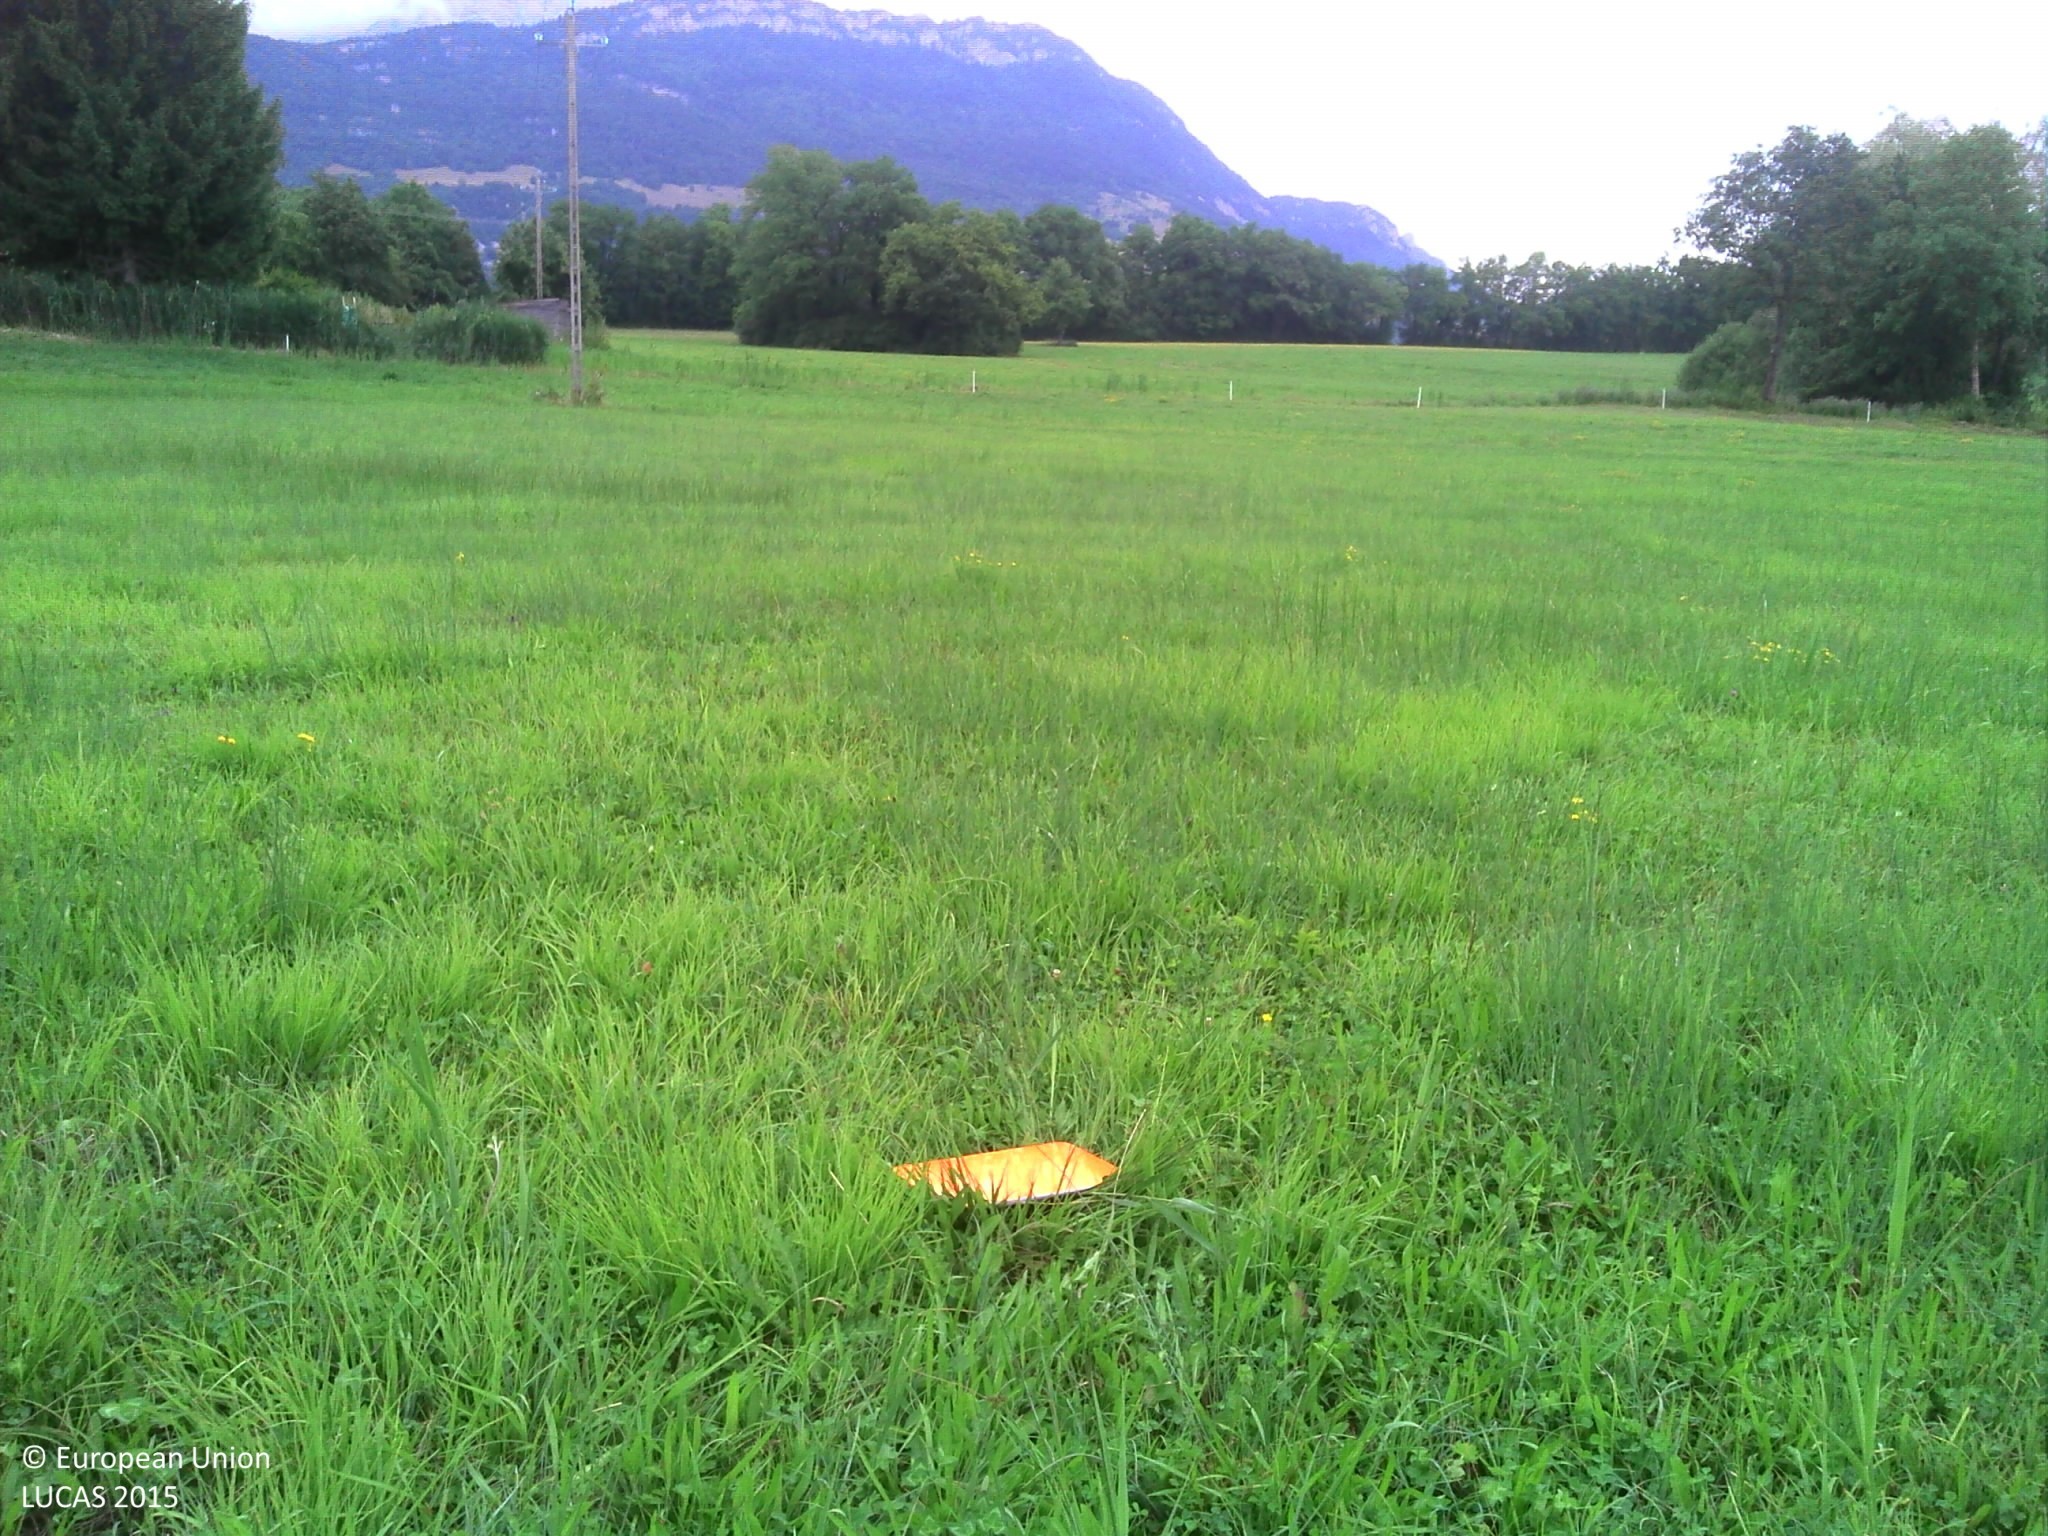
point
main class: Grassland
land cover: Grassland without tree/shrub cover
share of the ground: > 75 %
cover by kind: herbaceous plants 100 %
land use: Agriculture (excluding fallow land and kitchen gardens)
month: July
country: FR
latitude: 44.9438
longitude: 5.6082
